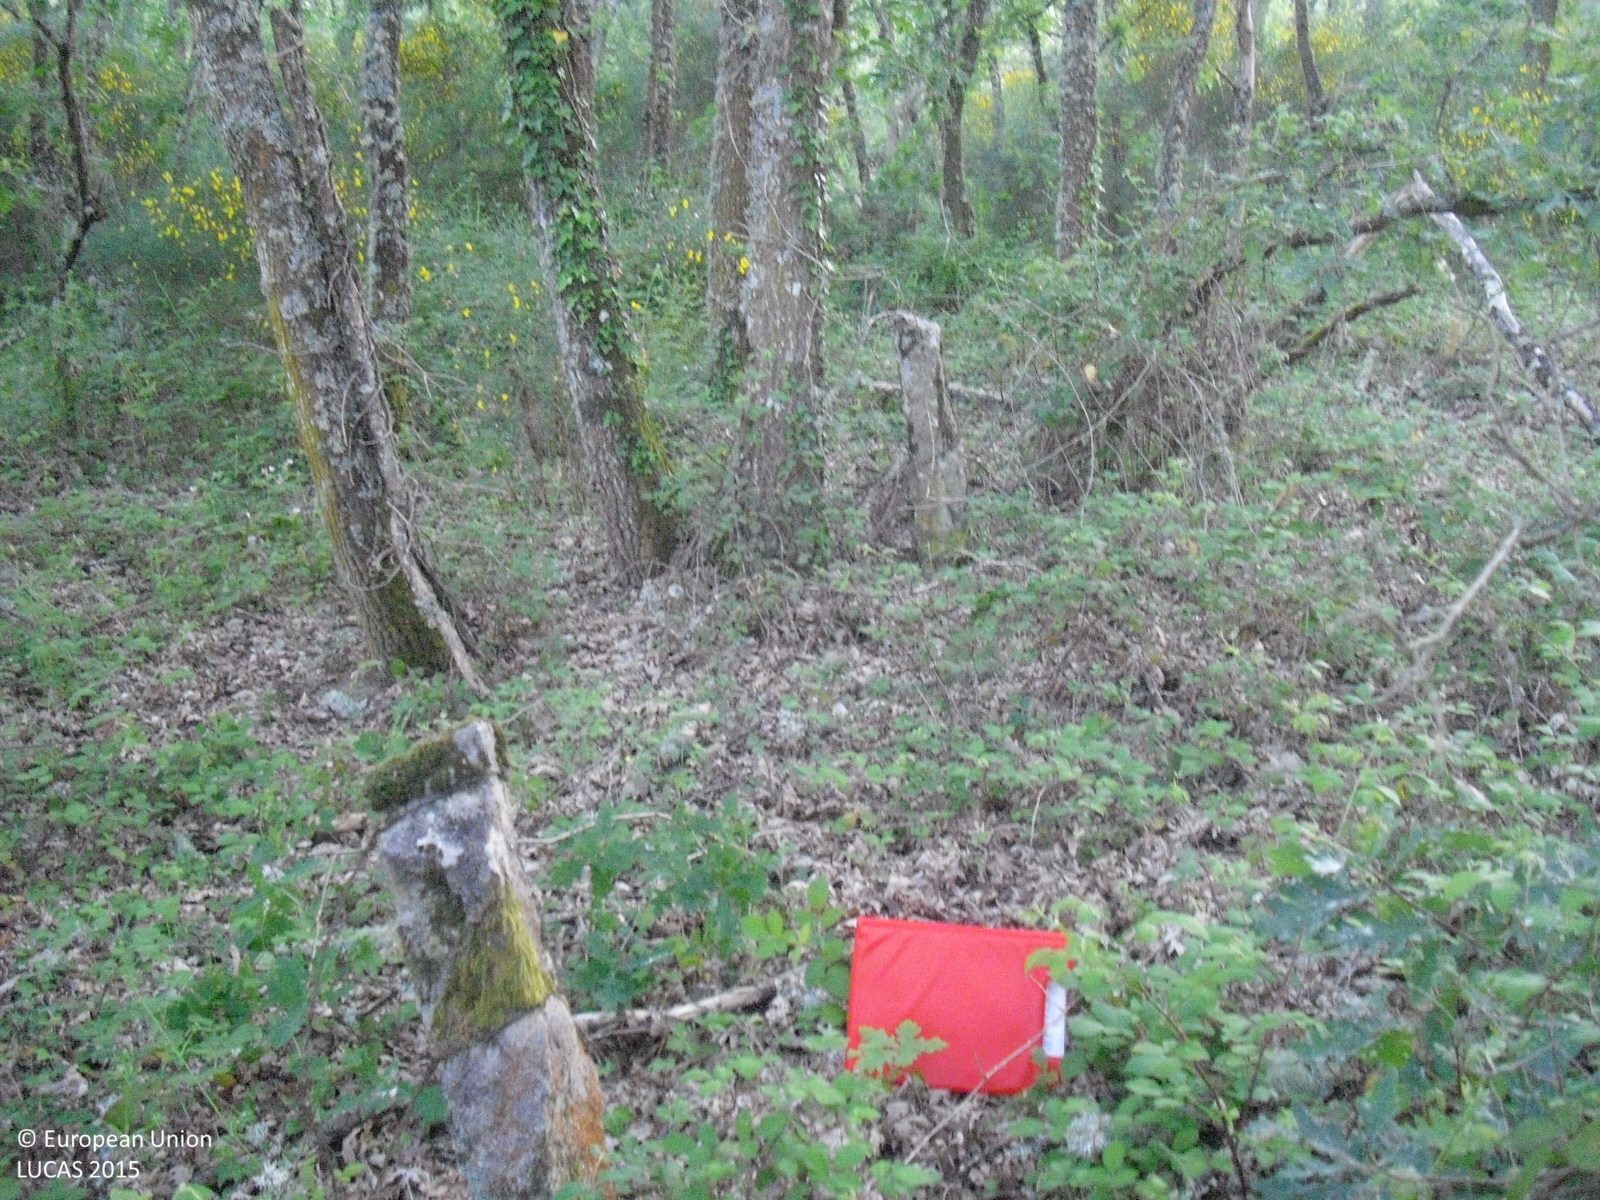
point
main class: Woodland
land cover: Broadleaved woodland
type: acidophilous oak and oak-birch forest
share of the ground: > 75 %
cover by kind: broadleaved forest trees 100 %
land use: Forestry
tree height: > 5 m
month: May
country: ES
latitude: 42.2157
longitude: -7.7461
